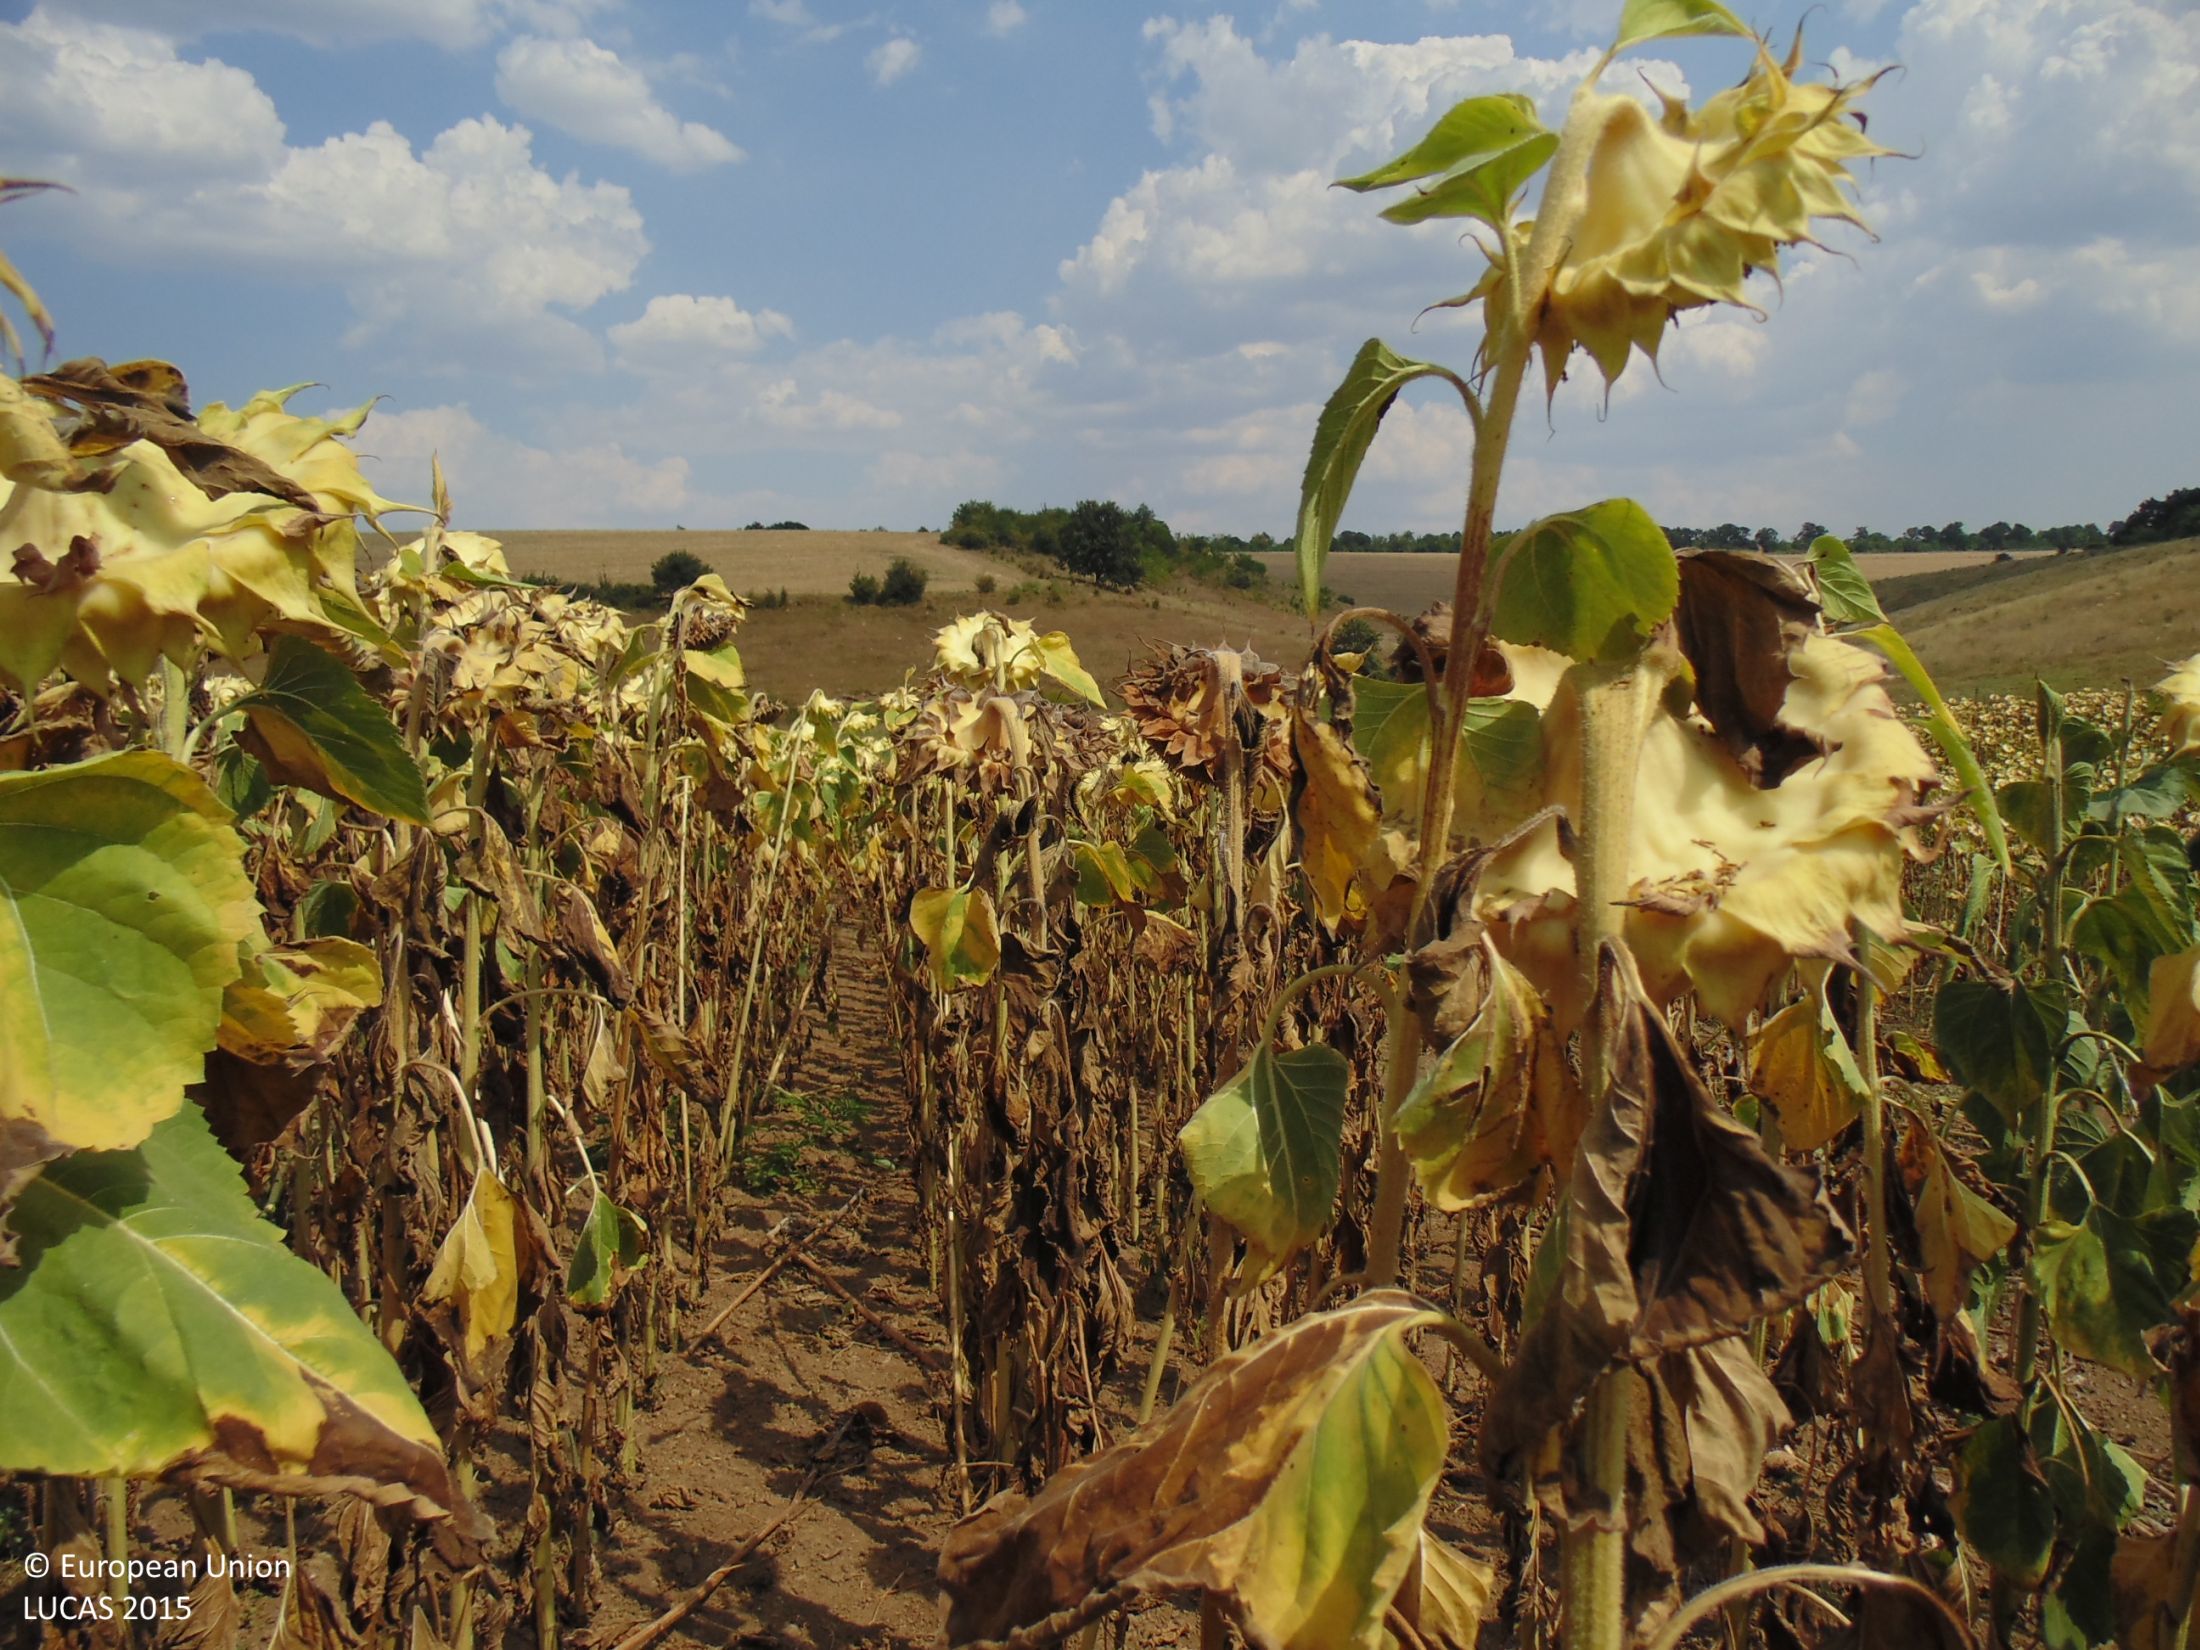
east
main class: Cropland
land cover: Sunflower
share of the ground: > 75 %
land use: Agriculture (excluding fallow land and kitchen gardens)
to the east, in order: Sunflower; Grassland with sparse tree/shrub cover; Tracks; Grassland without tree/shrub cover; Tracks; Grassland without tree/shrub cover; Tracks; Ditches and canals; Grassland with sparse tree/shrub cover; Common wheat
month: August
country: BG
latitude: 43.9603
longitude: 27.5739
